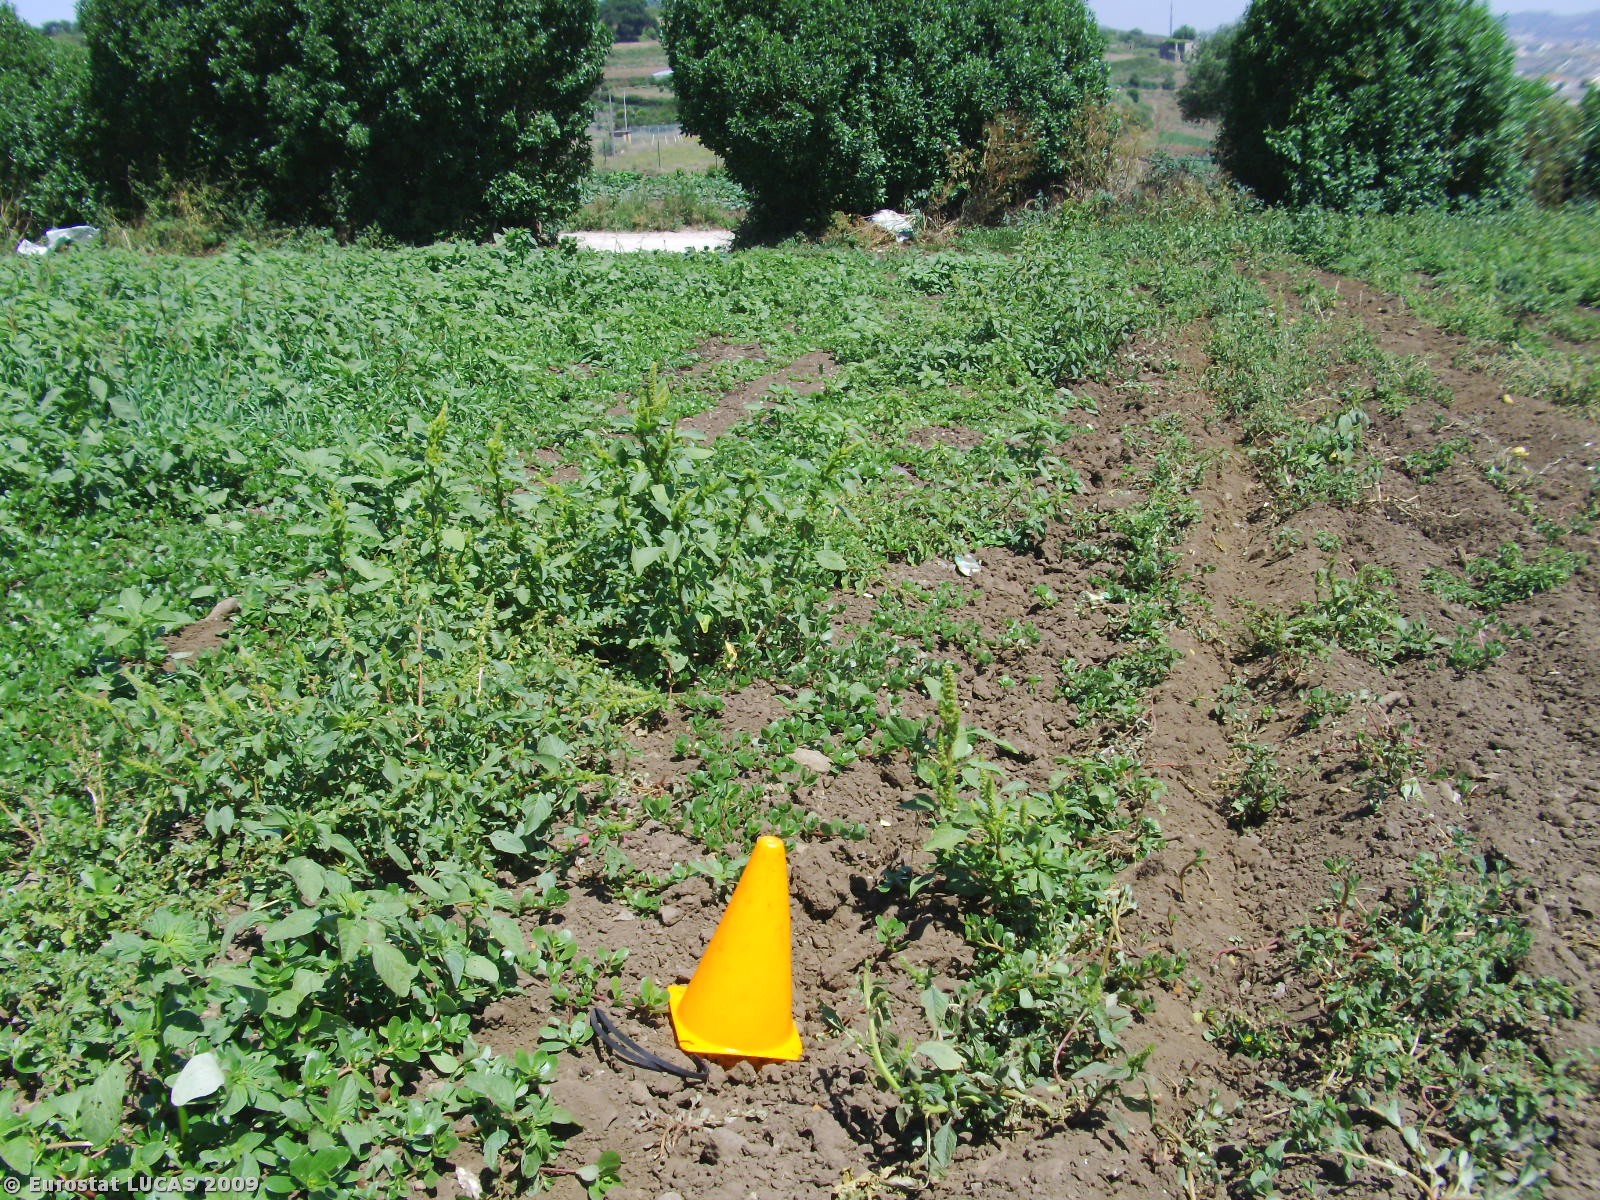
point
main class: Cropland
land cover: Potatoes
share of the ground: 25 - 50 %
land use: Agriculture (excluding fallow land and kitchen gardens)
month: July
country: PT
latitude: 38.8385
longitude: -9.2629
